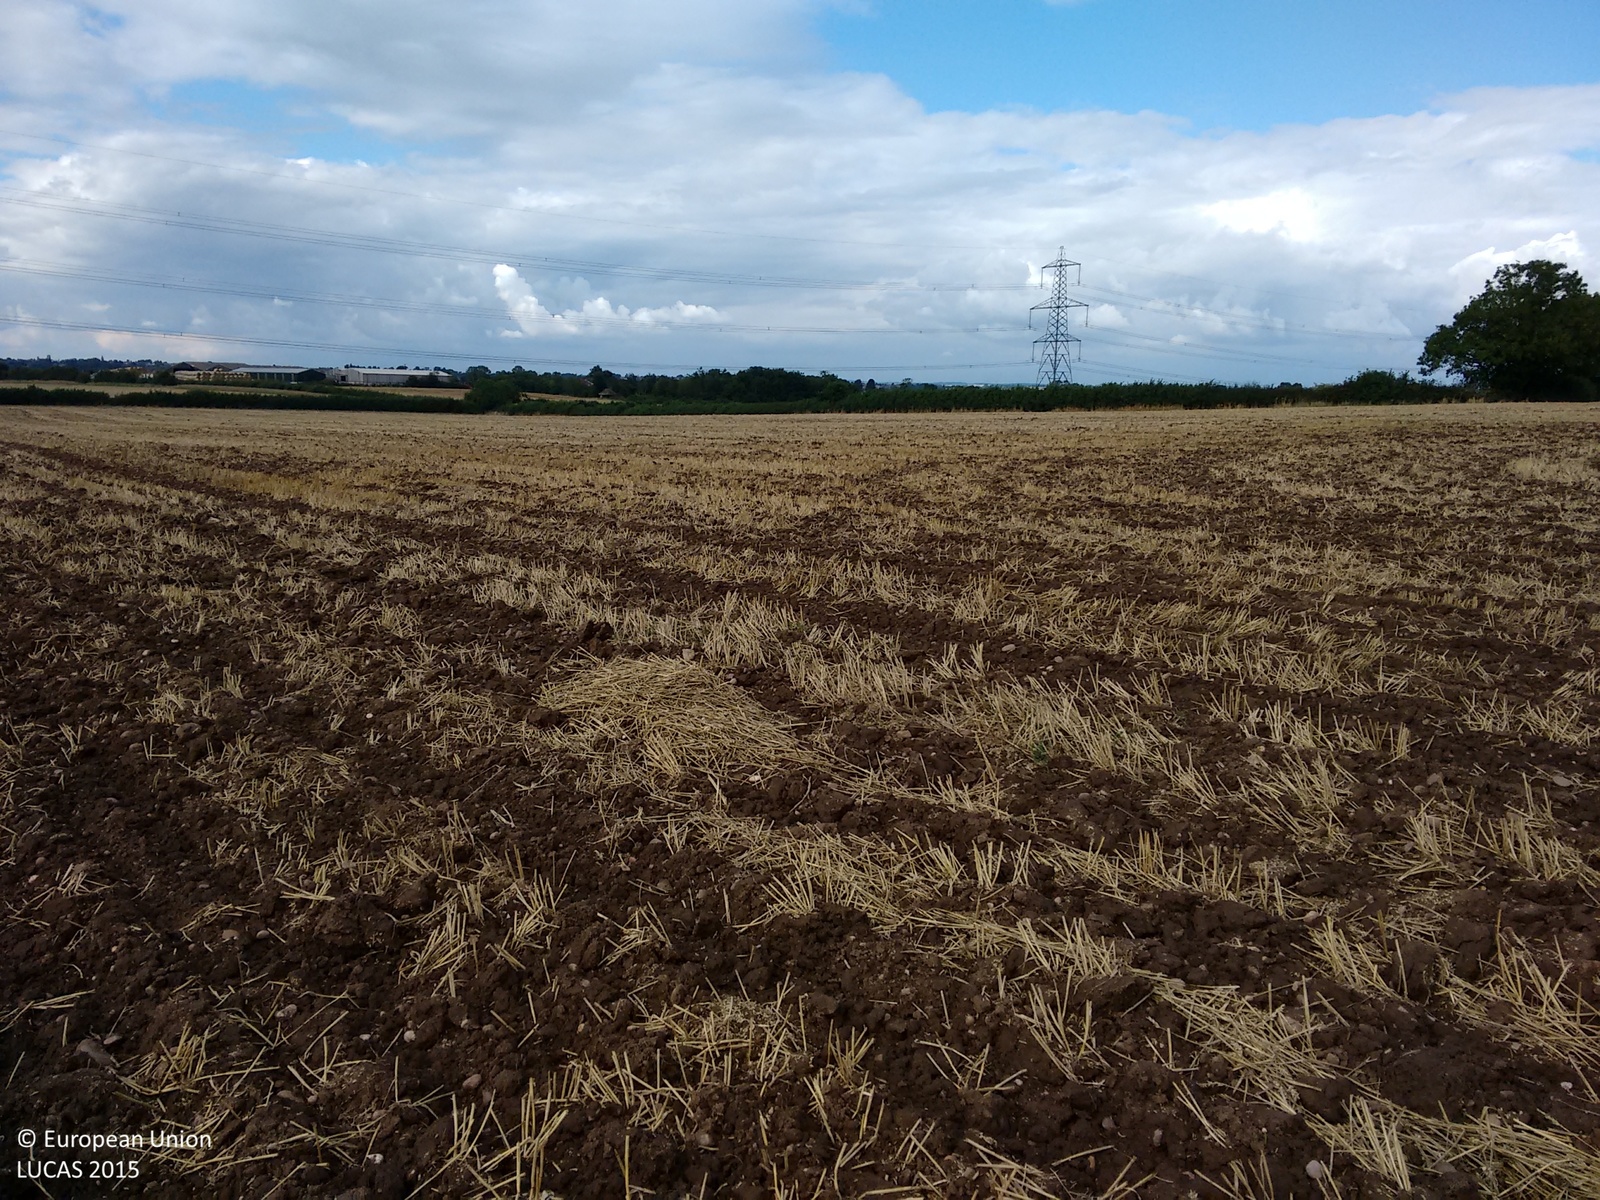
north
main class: Cropland
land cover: Common wheat
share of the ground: > 75 %
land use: Agriculture (excluding fallow land and kitchen gardens)
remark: Harvested field
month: September
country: GB
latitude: 52.5443
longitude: -1.2990
